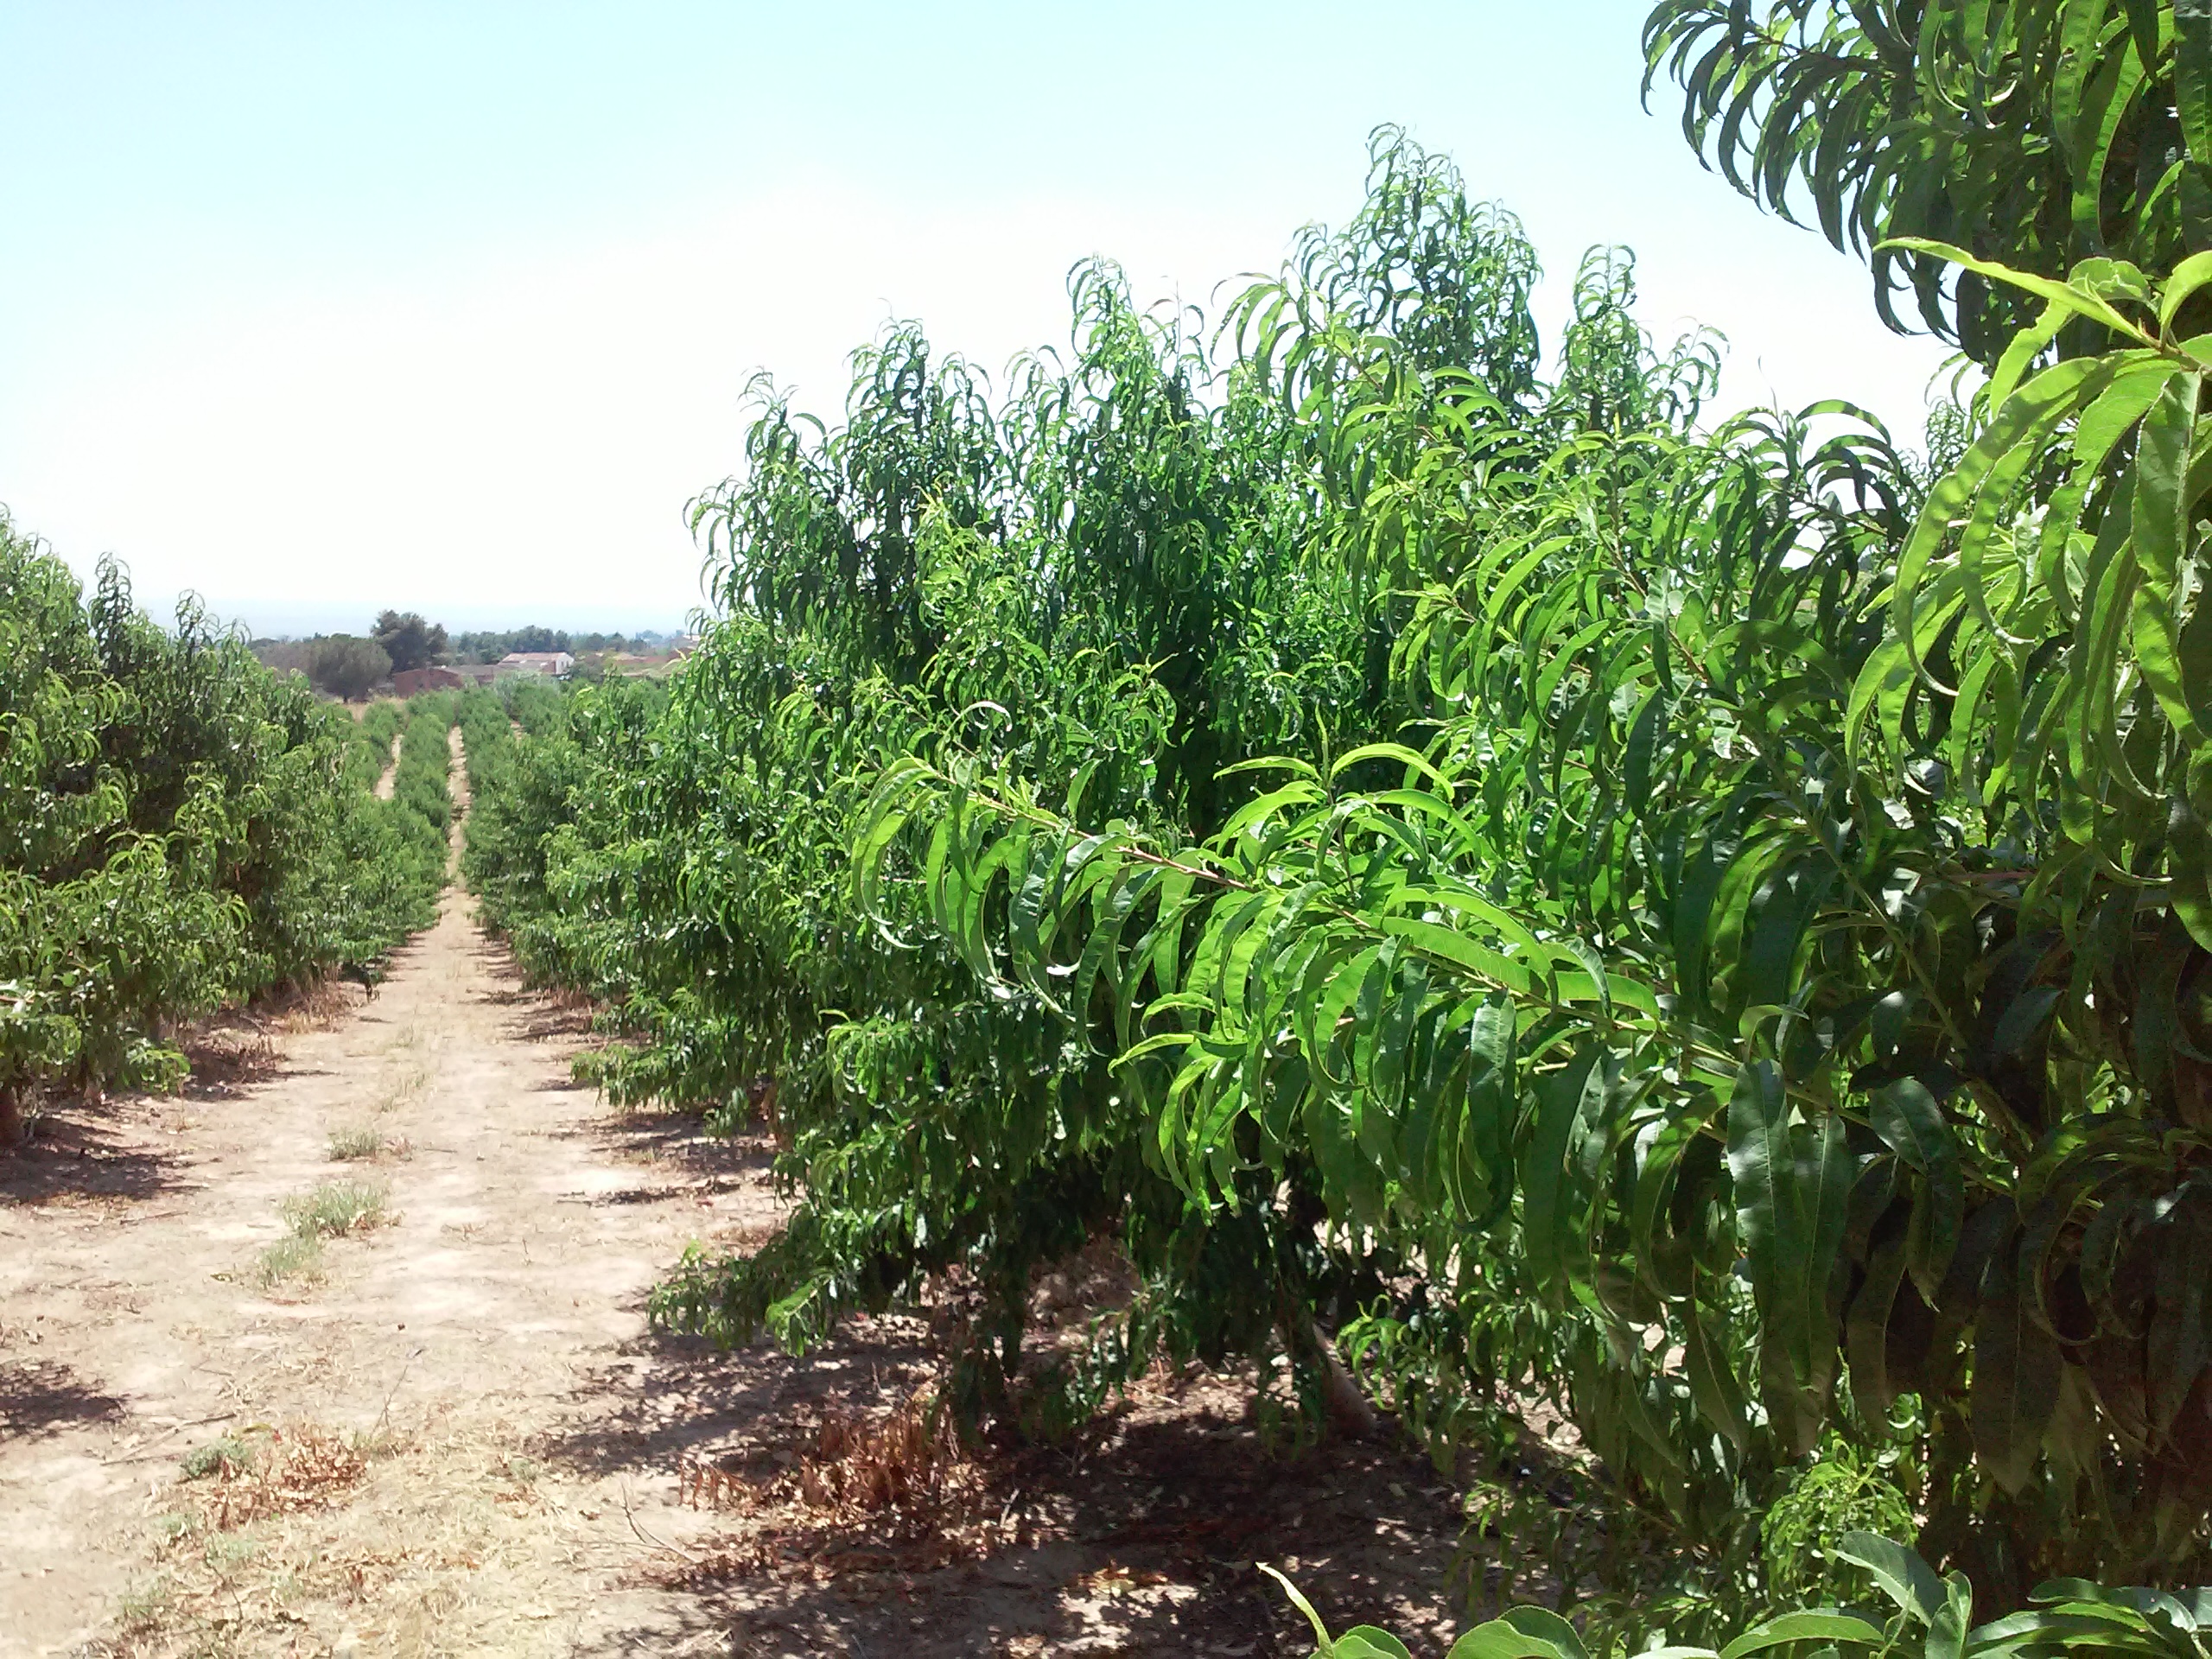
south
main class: Cropland
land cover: Other fruit trees and berries
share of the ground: 50 - 75 %
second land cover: Grassland without tree/shrub cover
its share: > 75 %
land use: Agriculture (excluding fallow land and kitchen gardens)
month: July
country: ES
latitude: 41.6467
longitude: 0.5378
